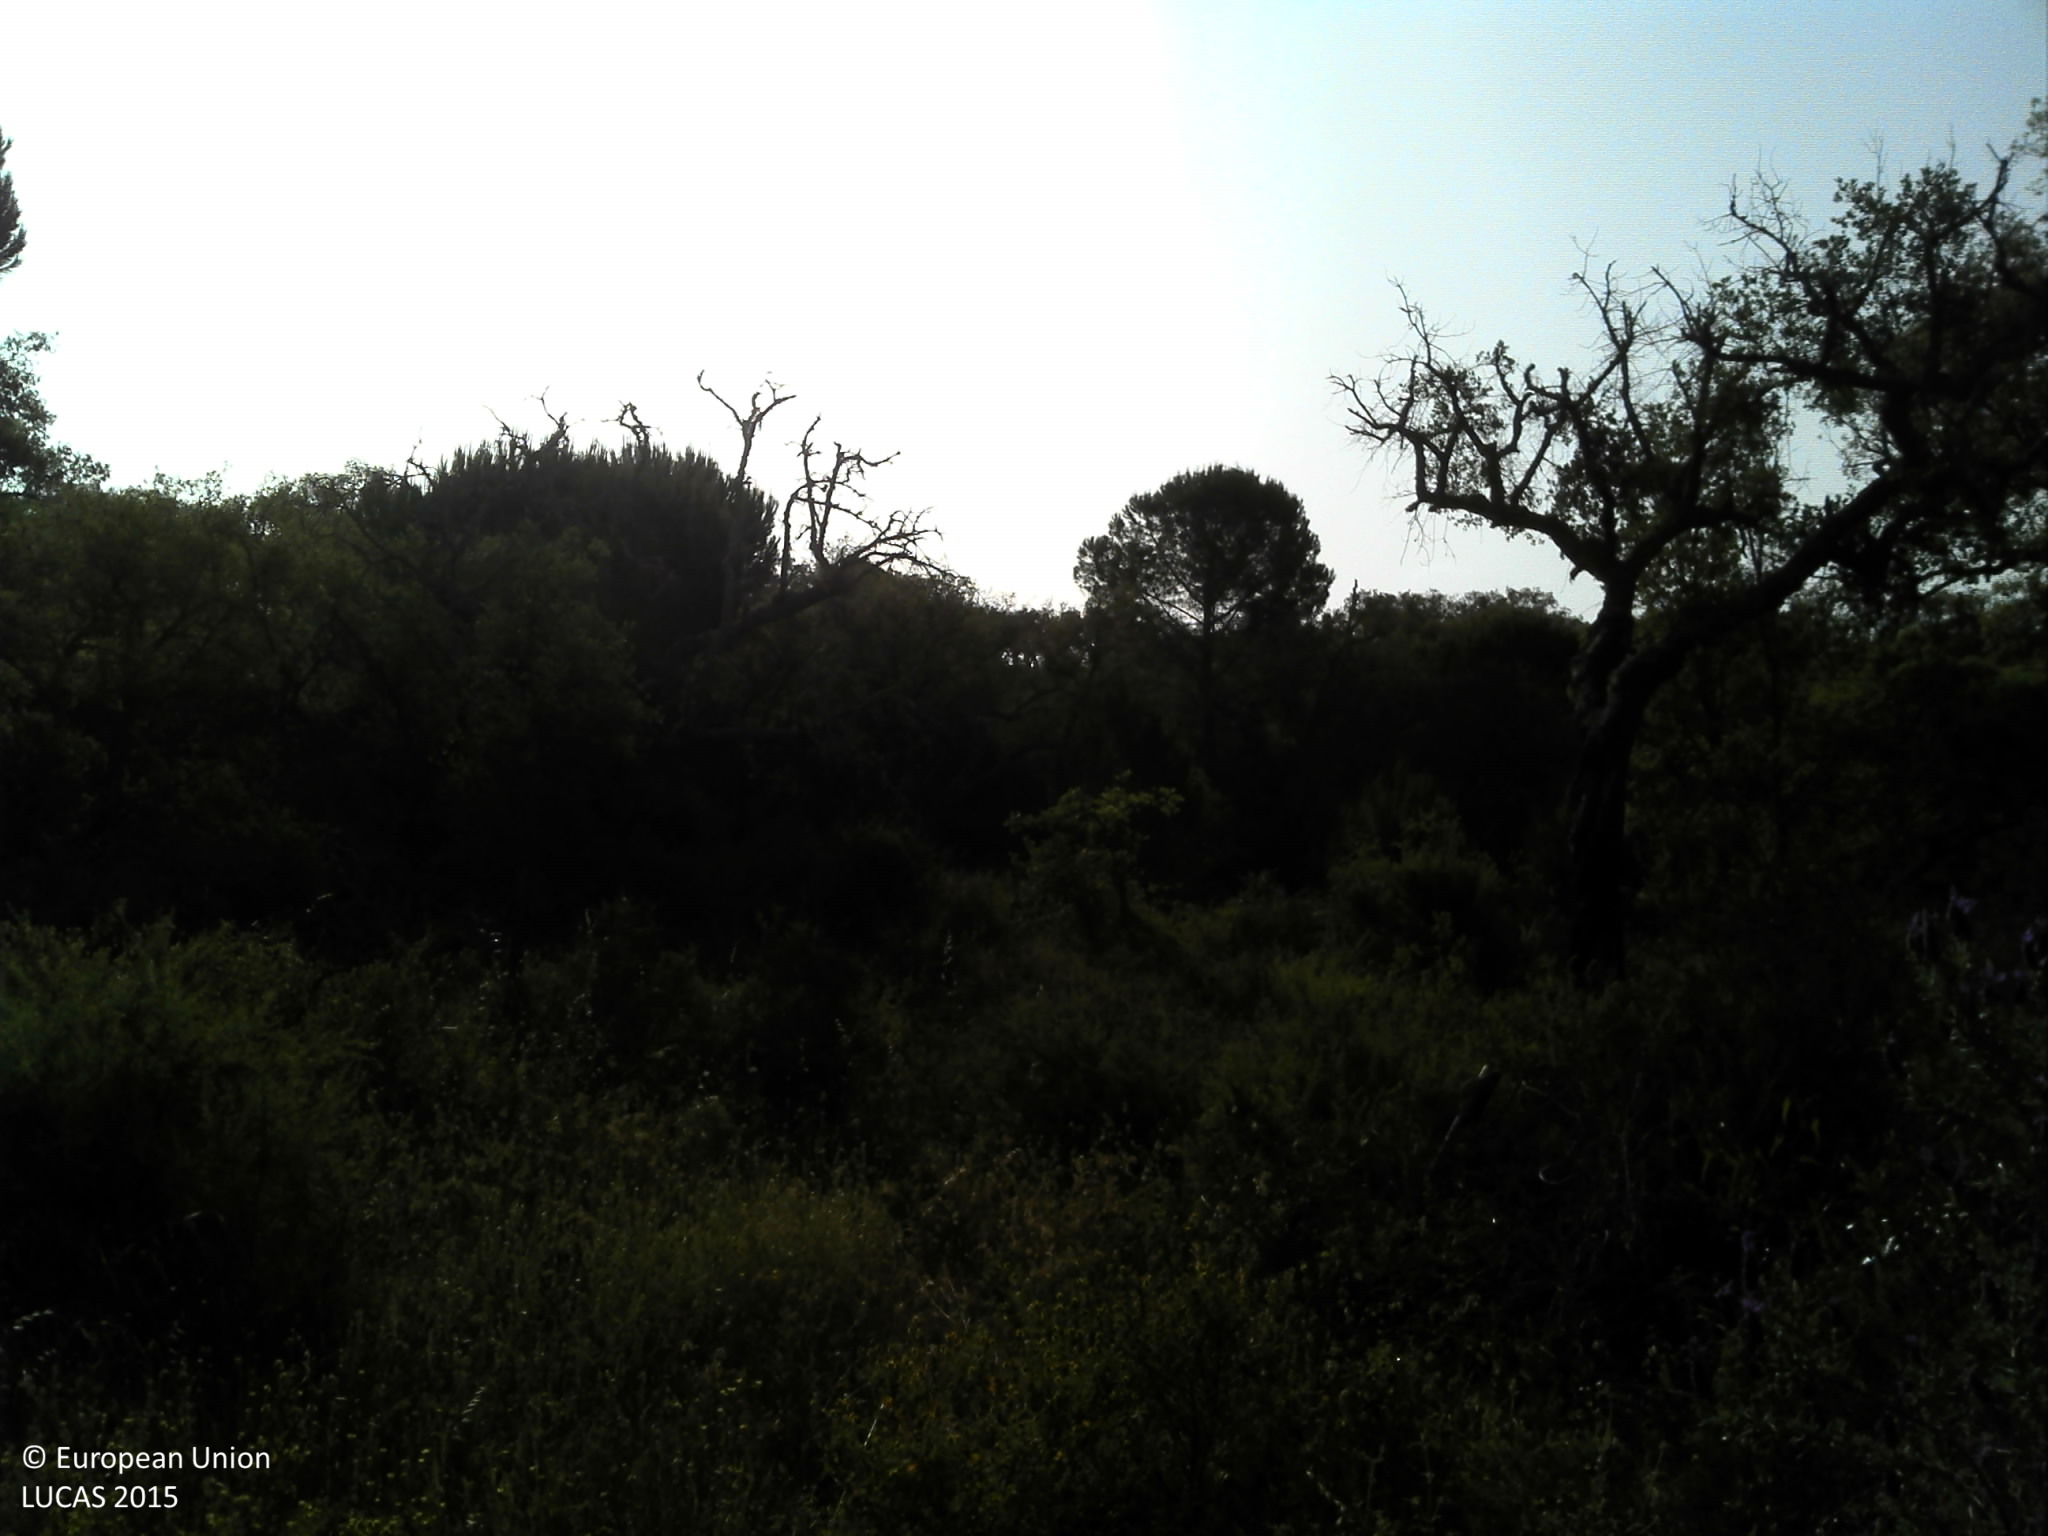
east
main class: Woodland
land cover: Broadleaved woodland
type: broadleaved evergreen forest
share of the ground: 10 - 25 %
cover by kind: shrubs 30 %, herbaceous plants 30 %, broadleaved forest trees 25 %, unconsolidated bare surface 10 %, coniferous forest trees 5 %
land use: Forestry
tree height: > 5 m
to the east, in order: Broadleaved woodland; Shrubland without tree cover; Rivers and streams; Broadleaved woodland; Rivers and streams; Broadleaved woodland; Tracks; Broadleaved woodland
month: May
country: PT
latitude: 38.3151
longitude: -8.4505
